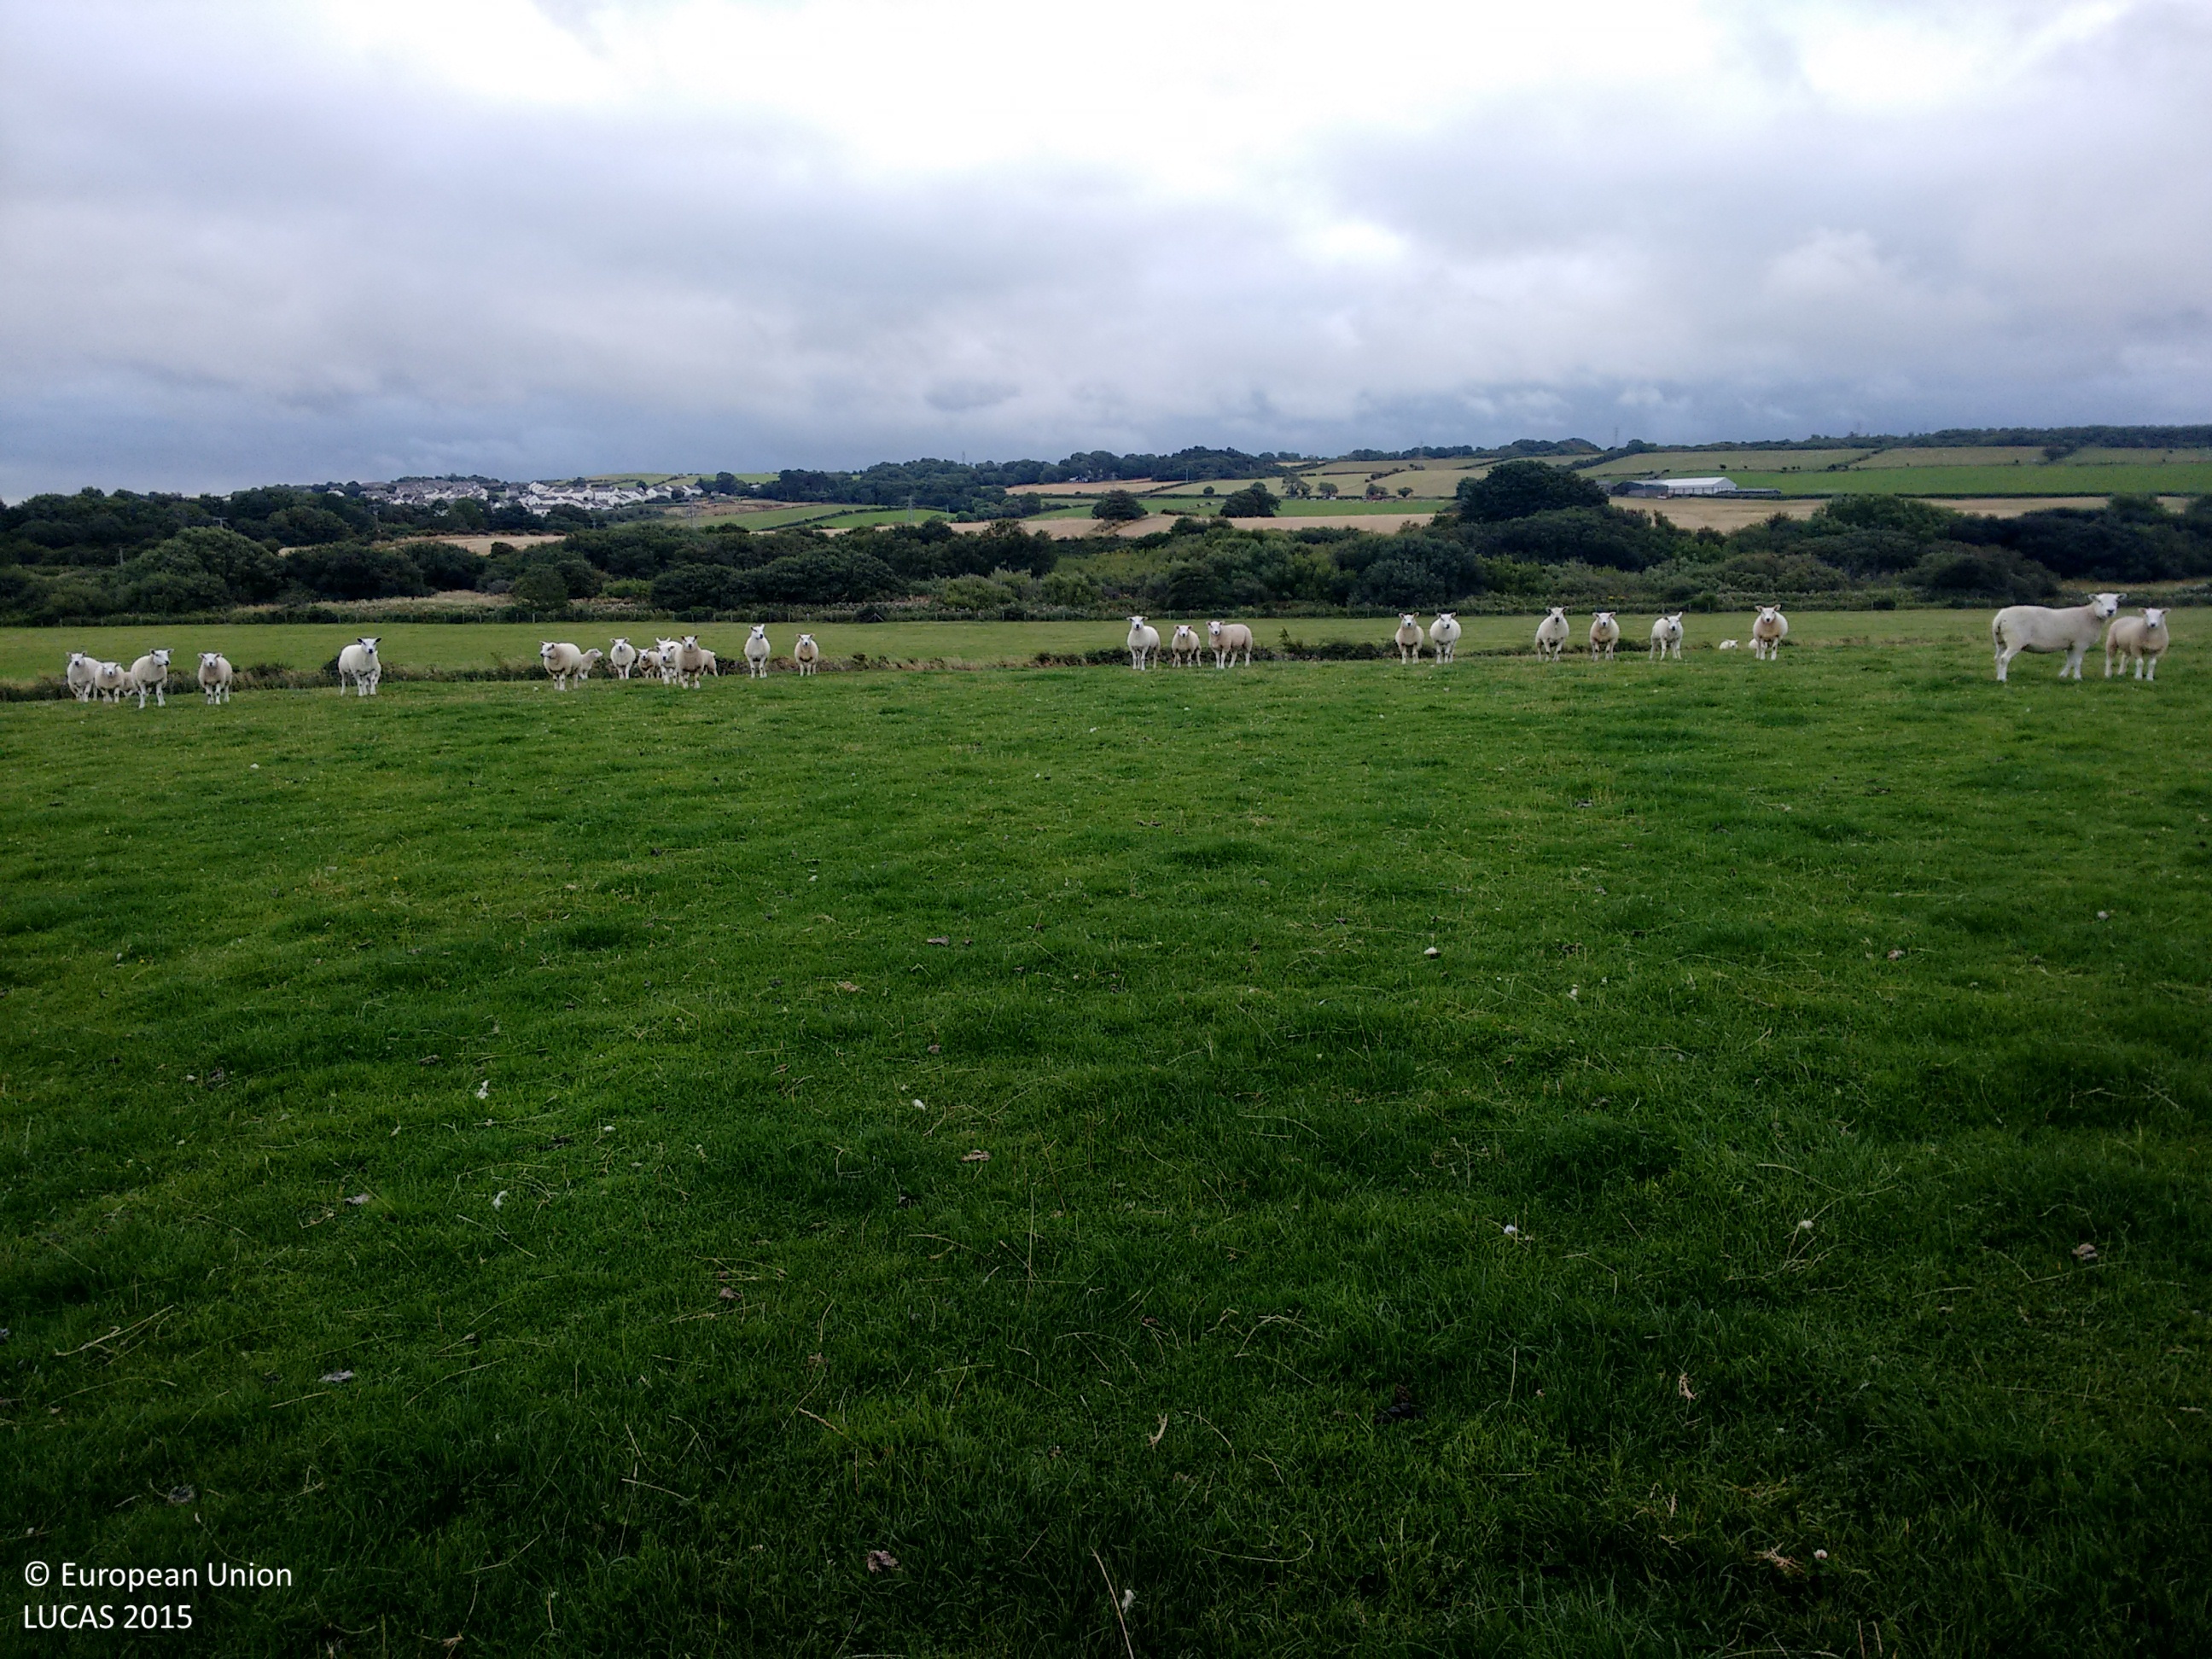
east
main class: Grassland
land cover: Grassland without tree/shrub cover
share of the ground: > 75 %
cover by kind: herbaceous plants 100 %
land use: Agriculture (excluding fallow land and kitchen gardens)
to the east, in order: Grassland without tree/shrub cover; Fences; Managed hedges; Fences; Grassland without tree/shrub cover; Fences; Grass margins; Ditches and canals; Broadleaved woodland; Inland marshes; Broadleaved woodland; Grassland with sparse tree/shrub cover
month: August
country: GB
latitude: 54.7027
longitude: -3.5049
